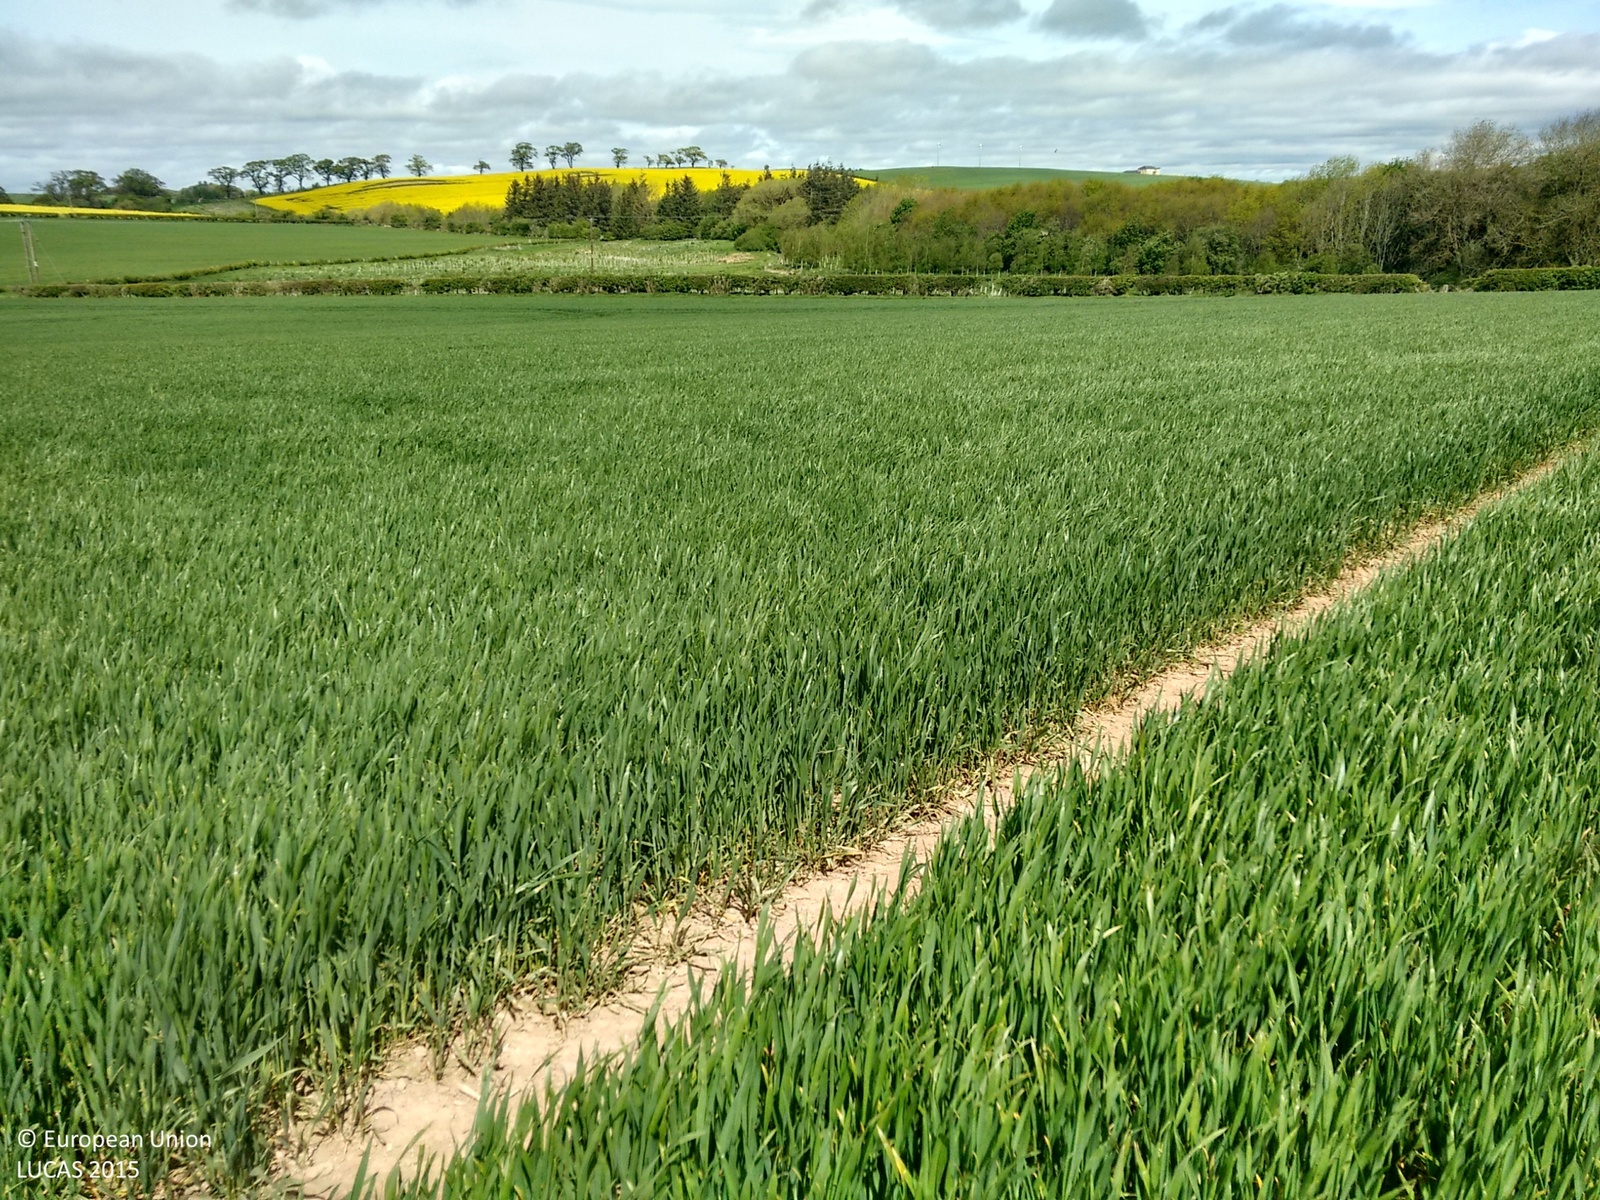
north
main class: Cropland
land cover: Common wheat
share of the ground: > 75 %
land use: Agriculture (excluding fallow land and kitchen gardens)
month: May
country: GB
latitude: 55.6409
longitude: -2.3713
